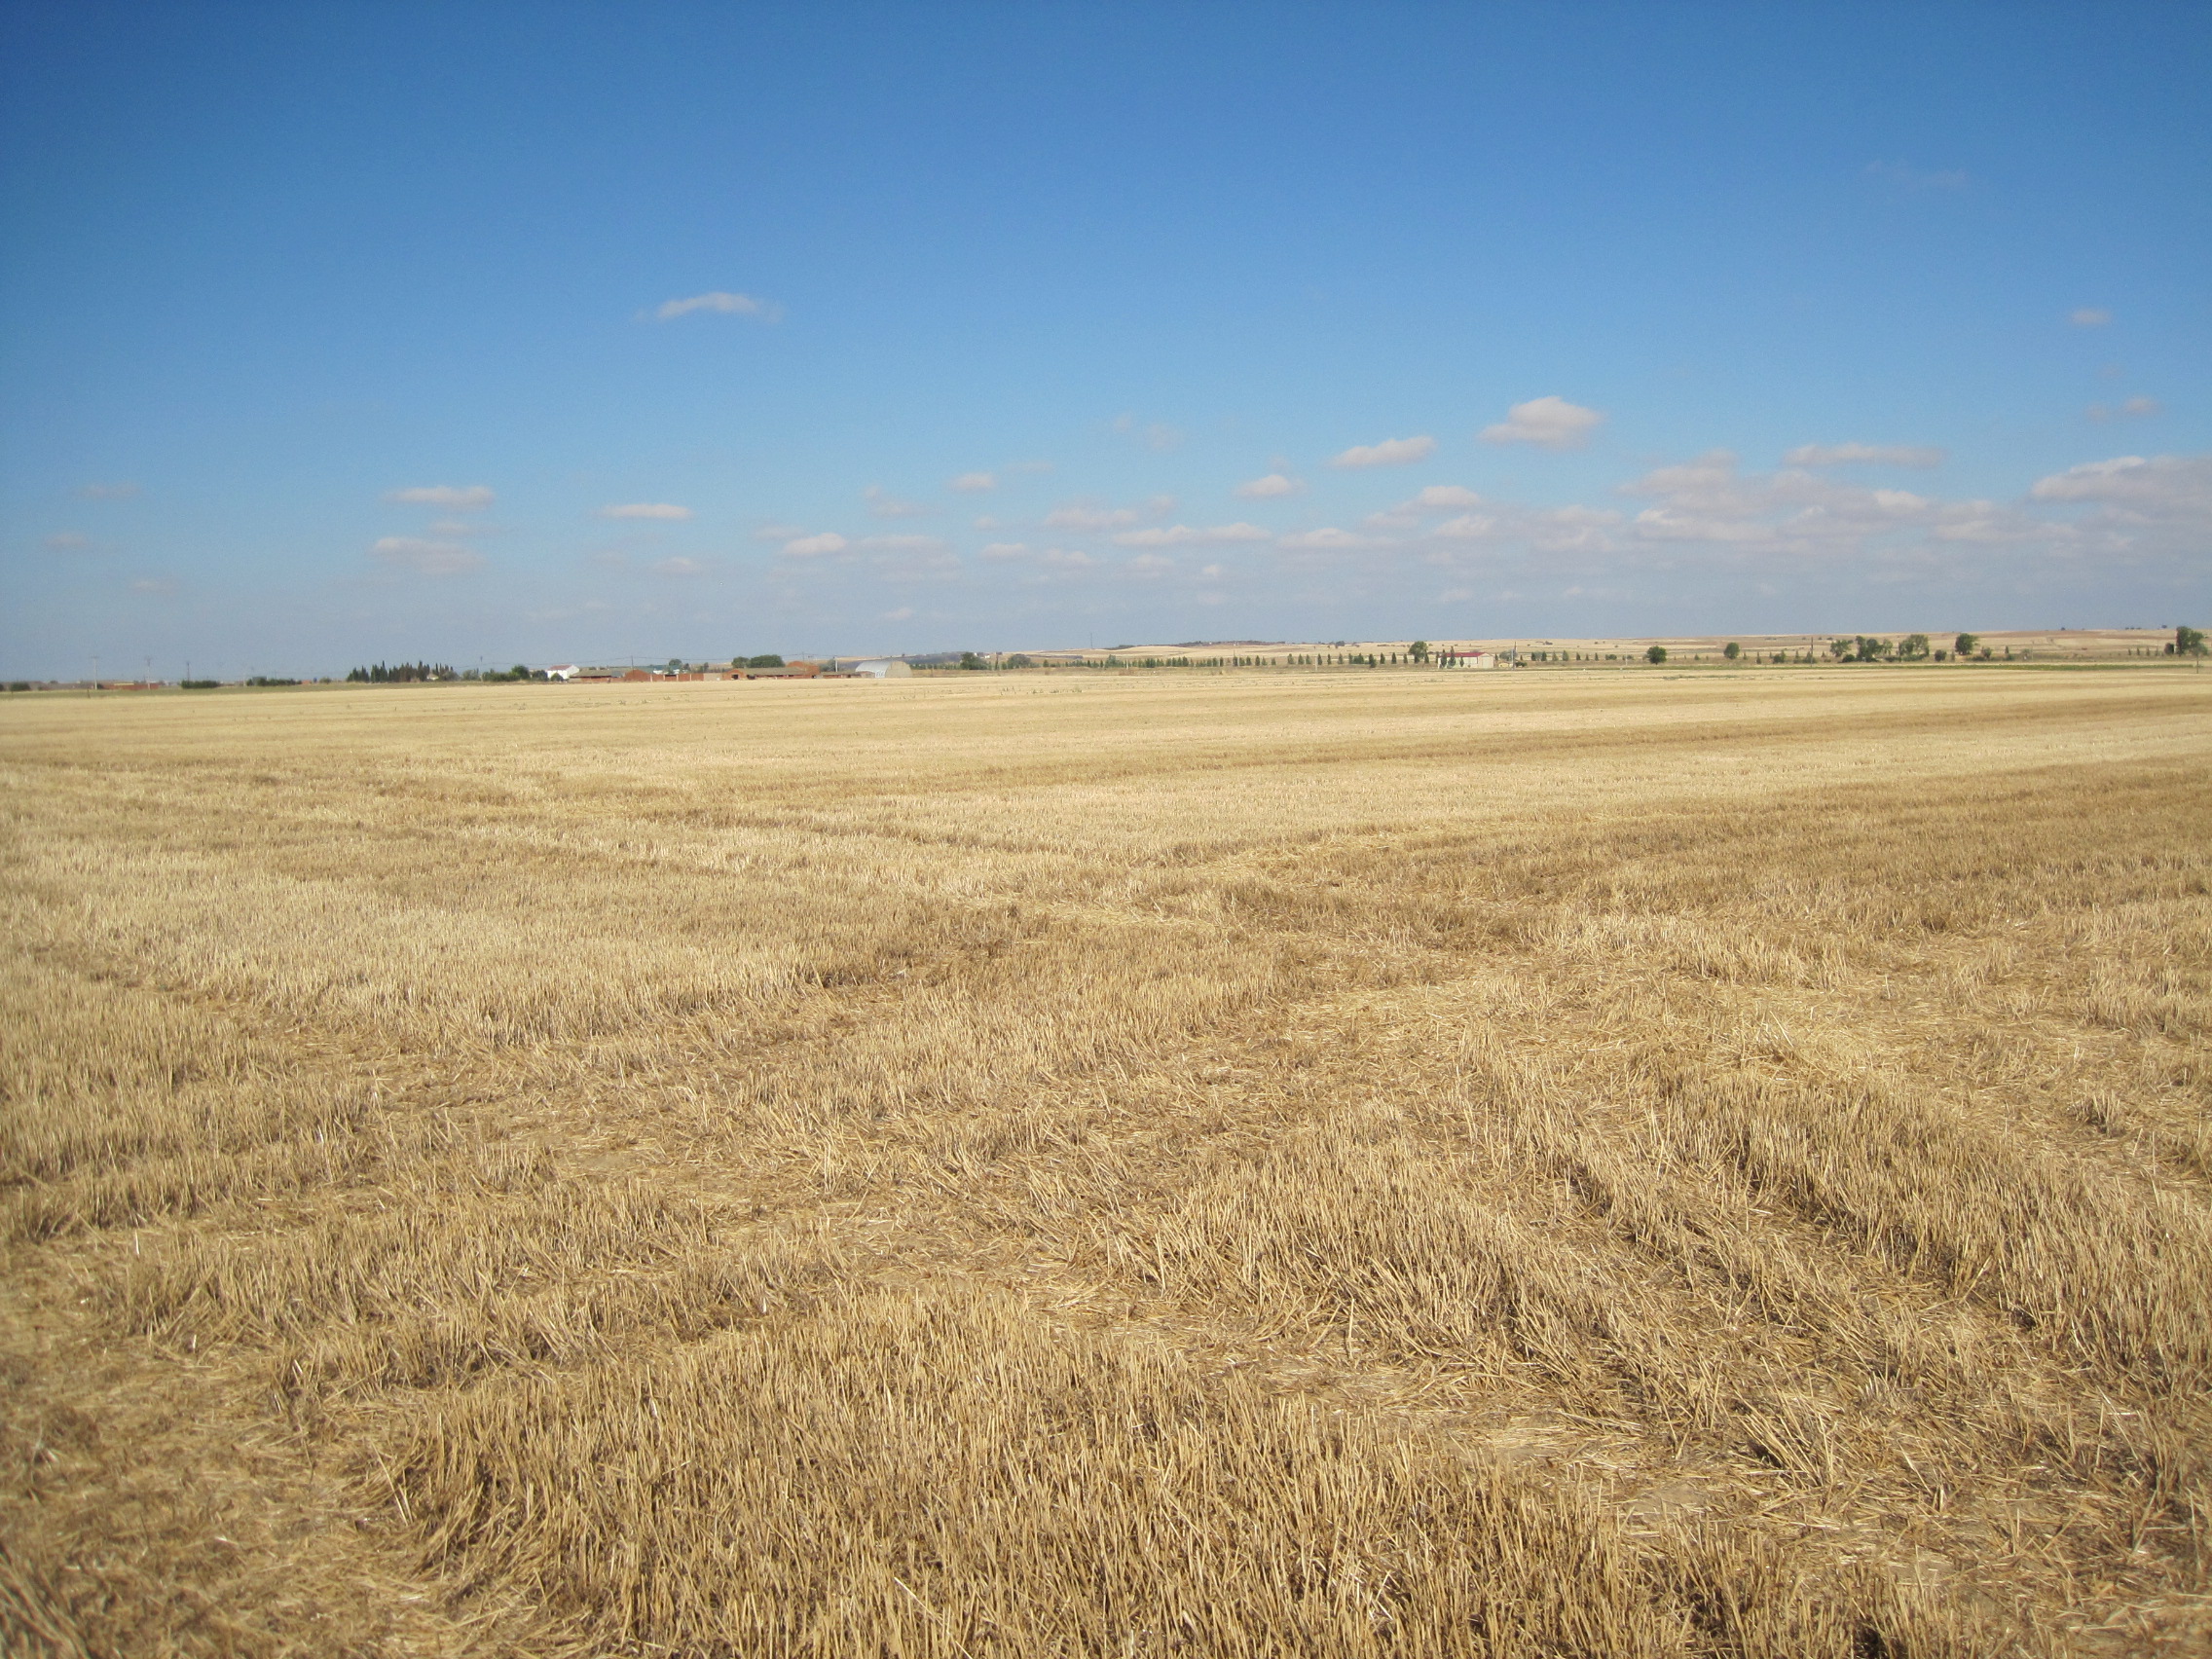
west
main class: Cropland
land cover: Barley
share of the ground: < 10 %
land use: Agriculture (excluding fallow land and kitchen gardens)
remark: Harvested field
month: July
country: ES
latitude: 41.8721
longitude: -5.3983
